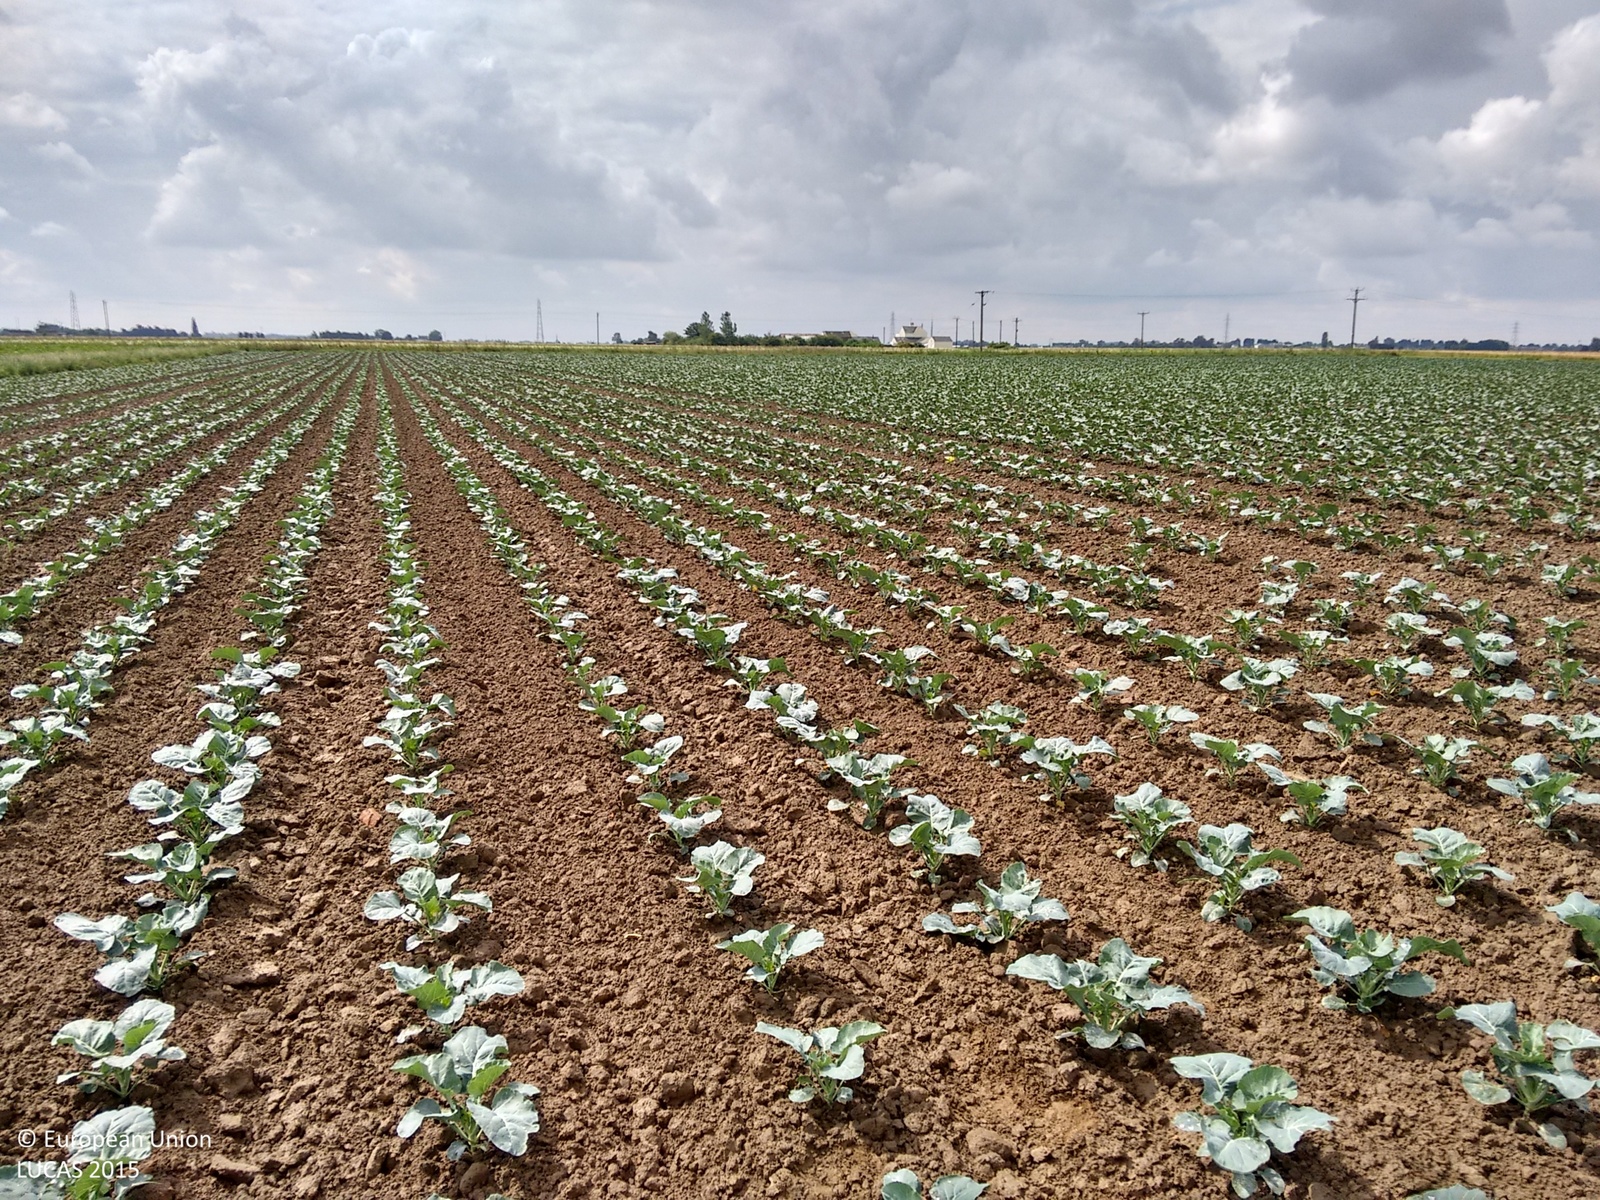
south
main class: Cropland
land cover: Other fresh vegetables
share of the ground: > 75 %
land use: Agriculture (excluding fallow land and kitchen gardens)
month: July
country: GB
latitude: 52.7615
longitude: -0.0955
